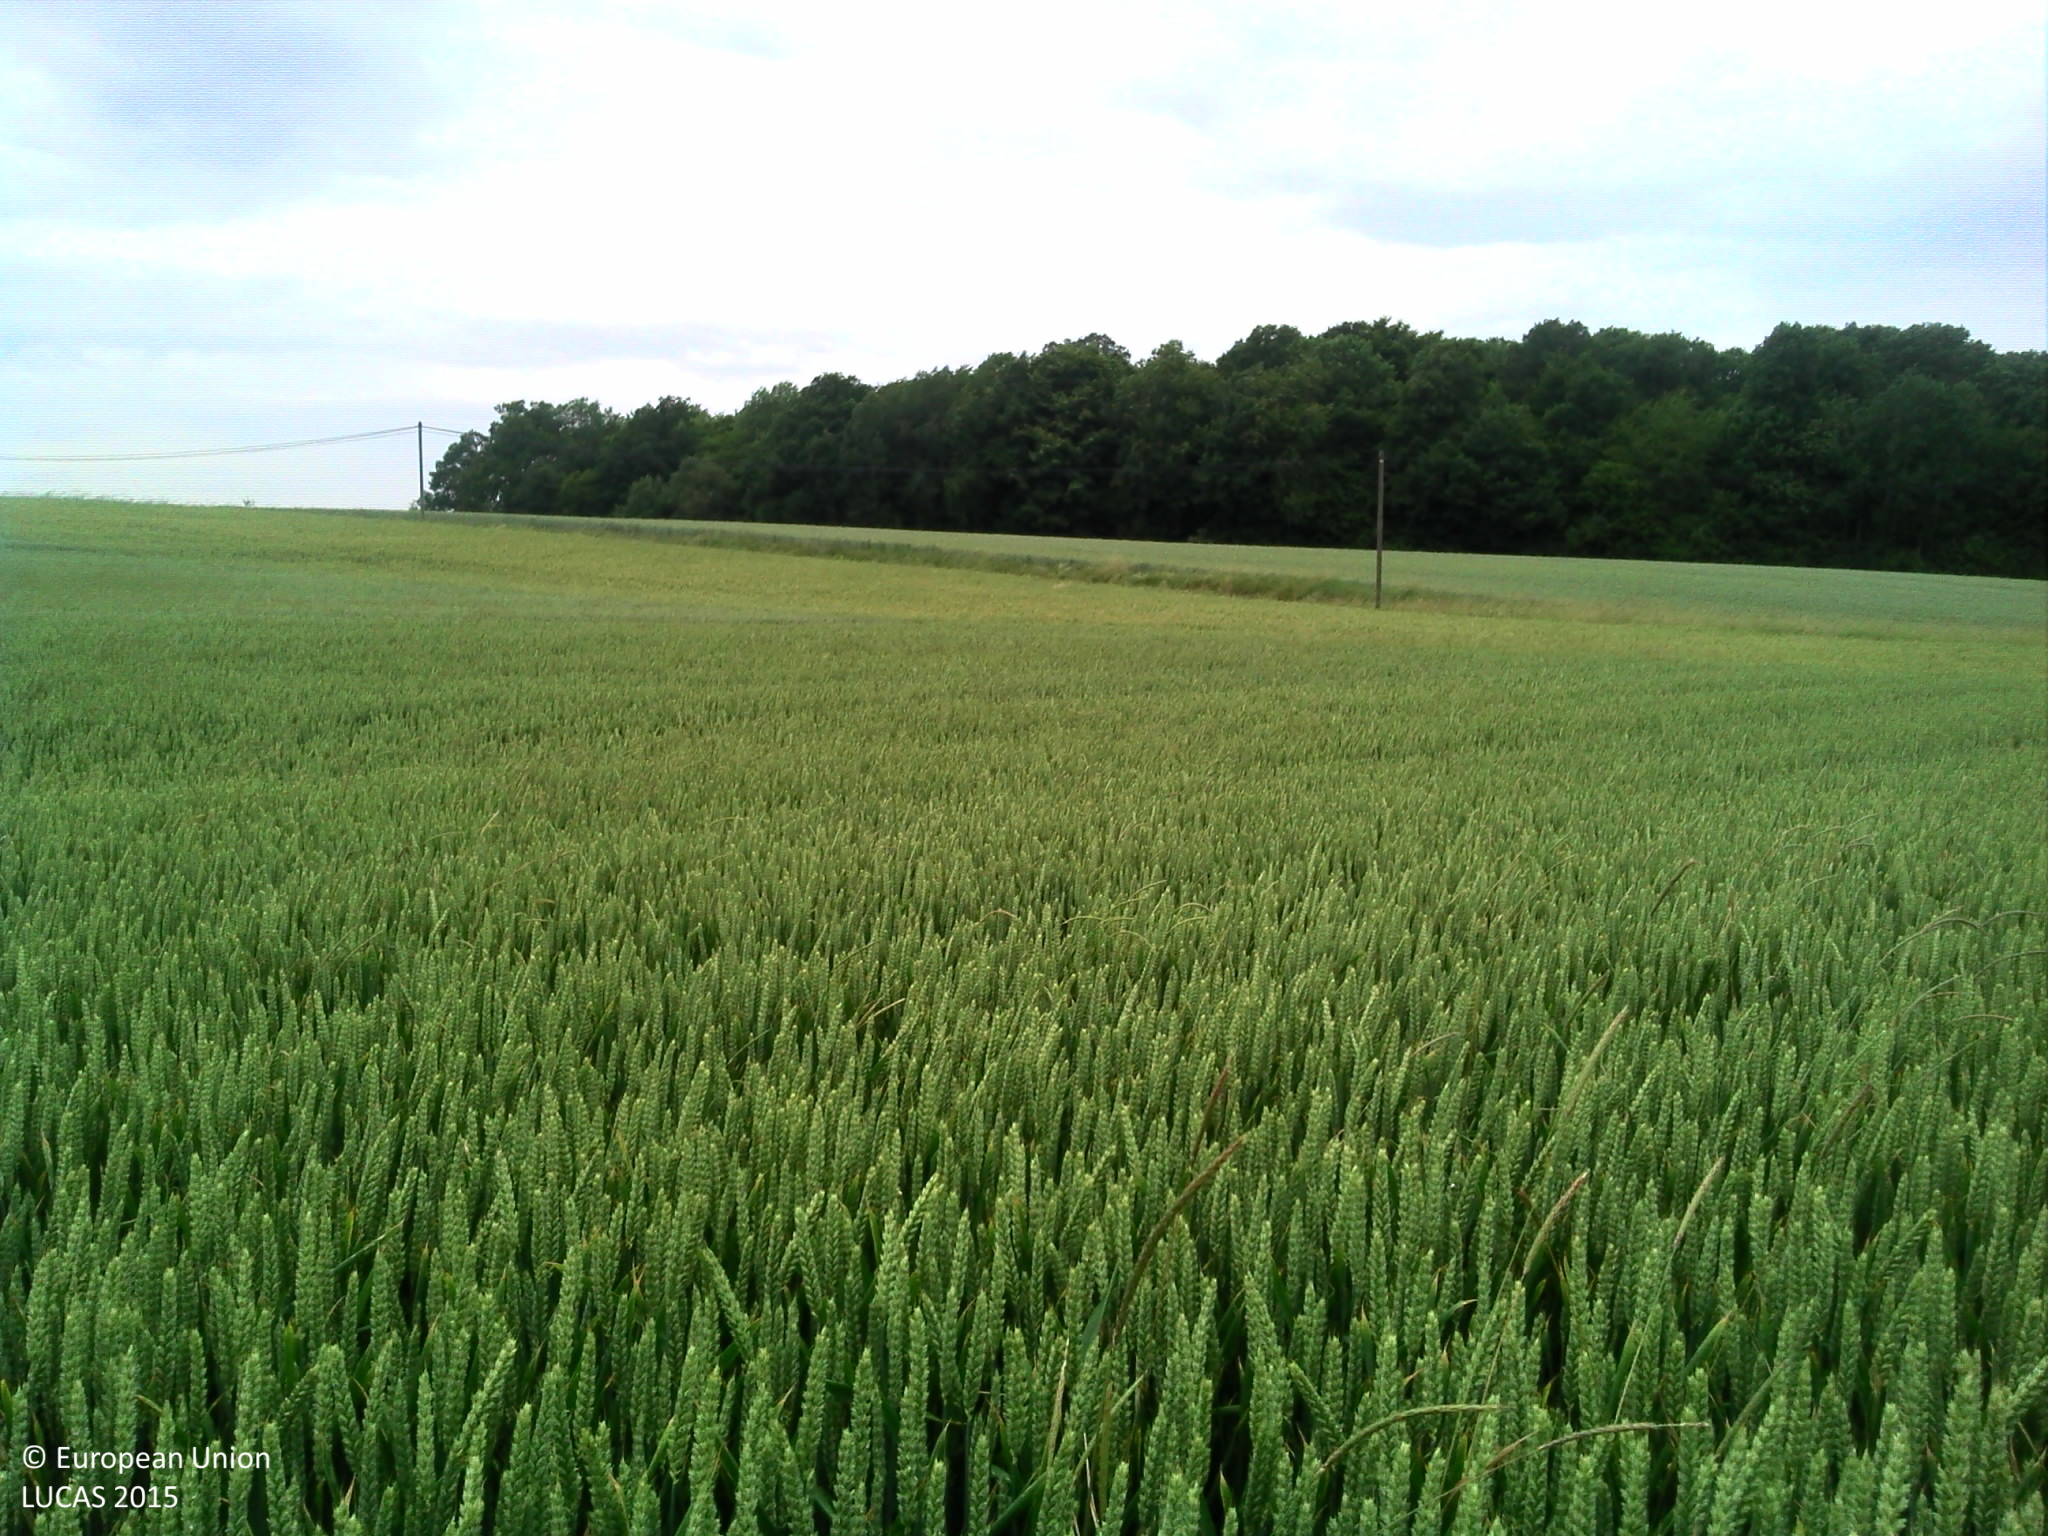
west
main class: Cropland
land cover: Common wheat
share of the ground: > 75 %
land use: Agriculture (excluding fallow land and kitchen gardens)
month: June
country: FR
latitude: 48.3572
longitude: 4.8834
